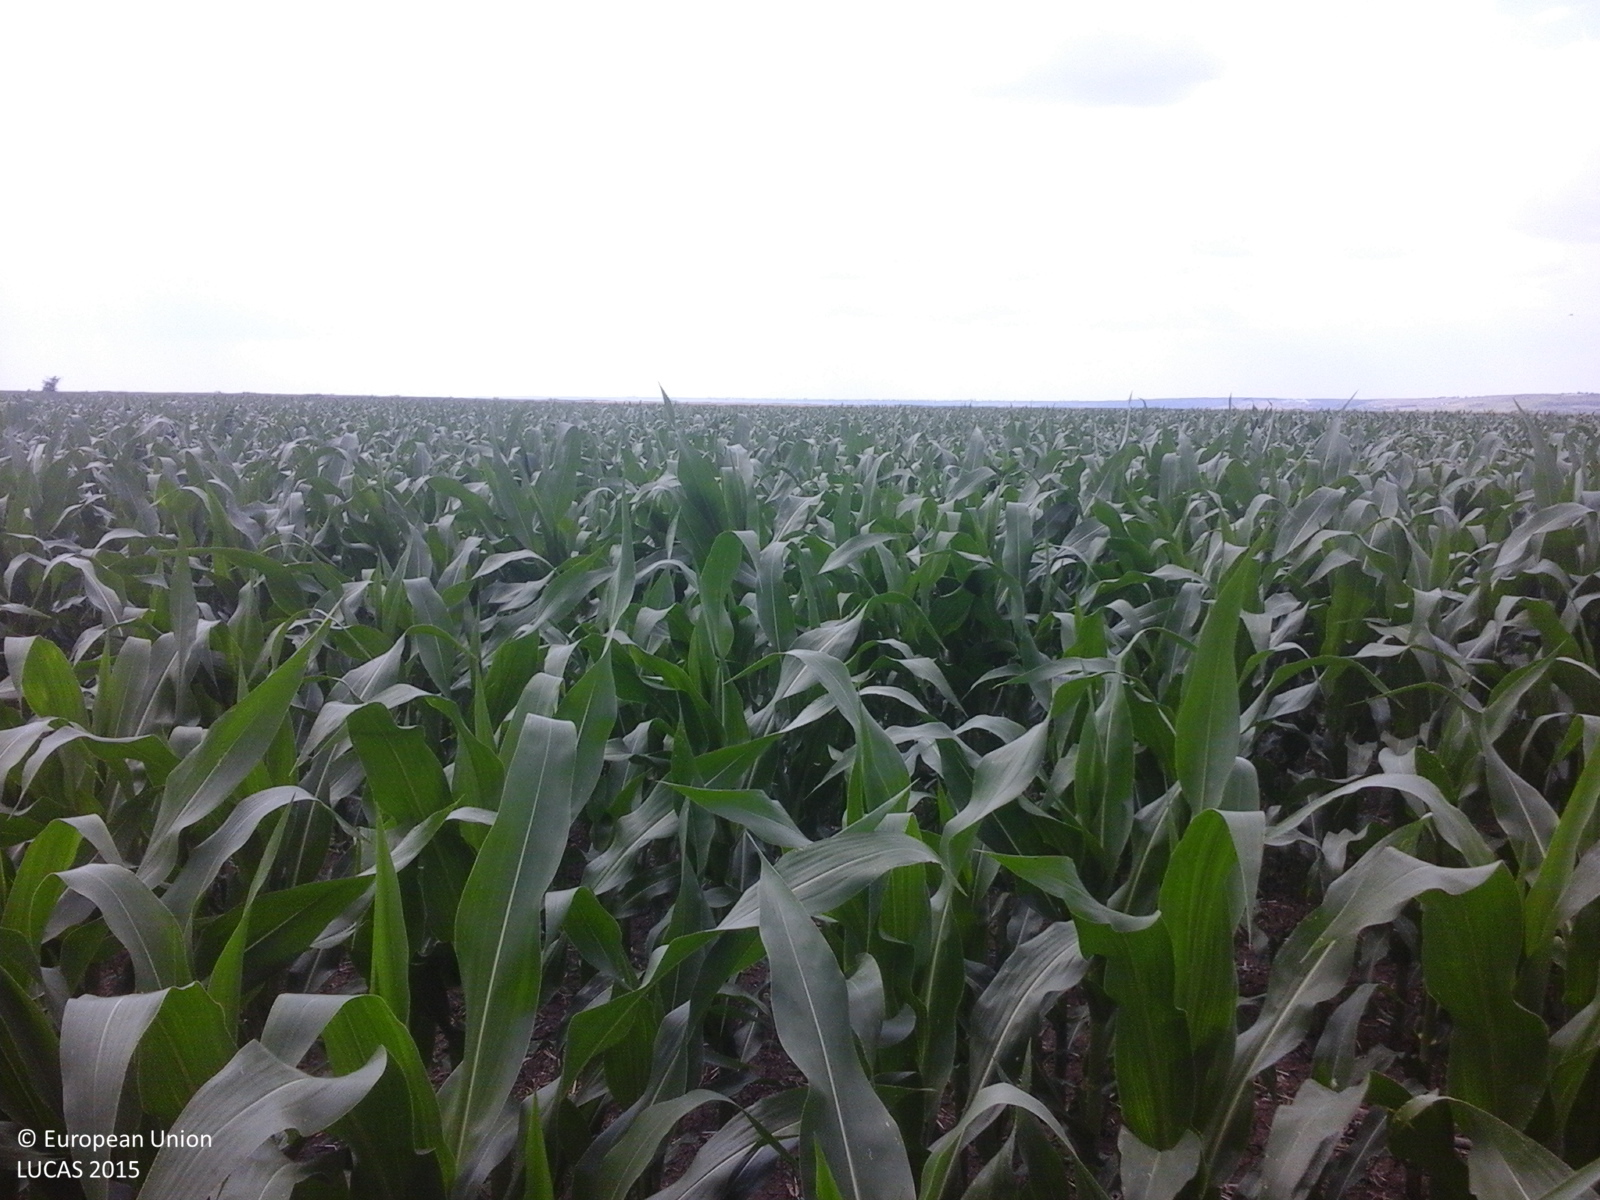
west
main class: Cropland
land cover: Maize
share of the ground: > 75 %
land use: Agriculture (excluding fallow land and kitchen gardens)
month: June
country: RO
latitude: 44.0832
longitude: 26.5086
